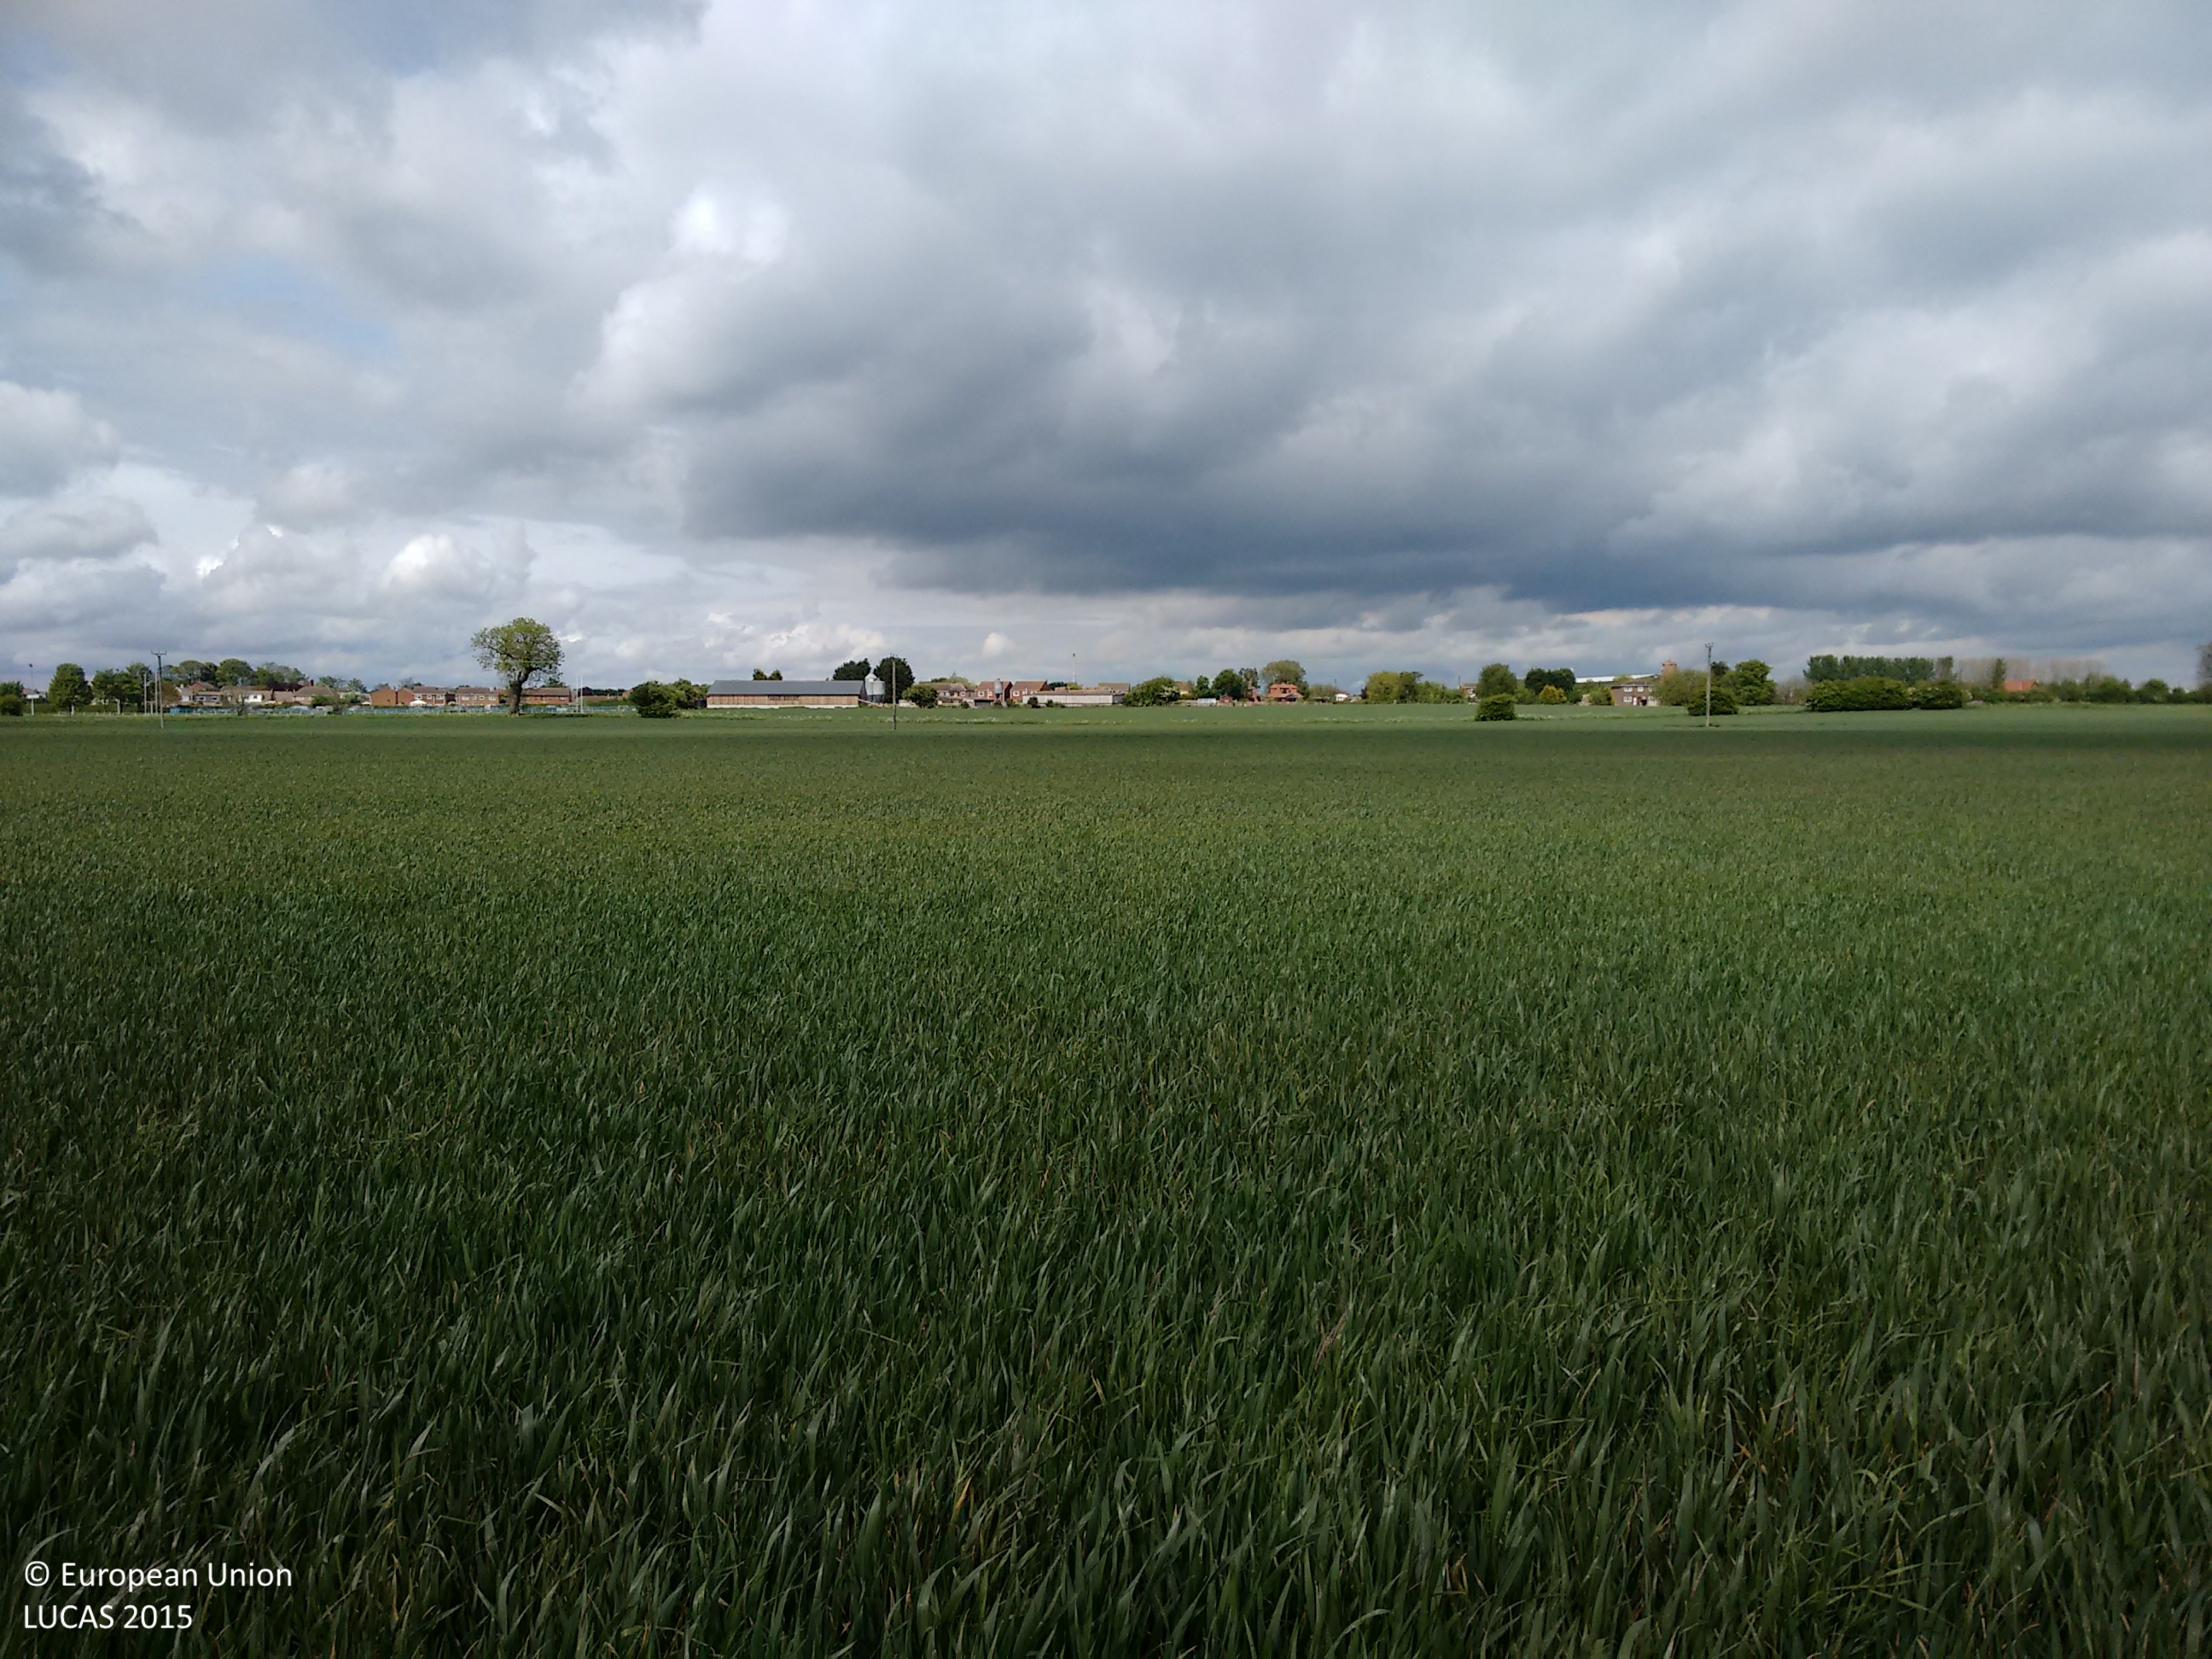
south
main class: Cropland
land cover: Common wheat
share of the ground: > 75 %
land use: Agriculture (excluding fallow land and kitchen gardens)
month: May
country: GB
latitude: 53.7031
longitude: -0.1060
